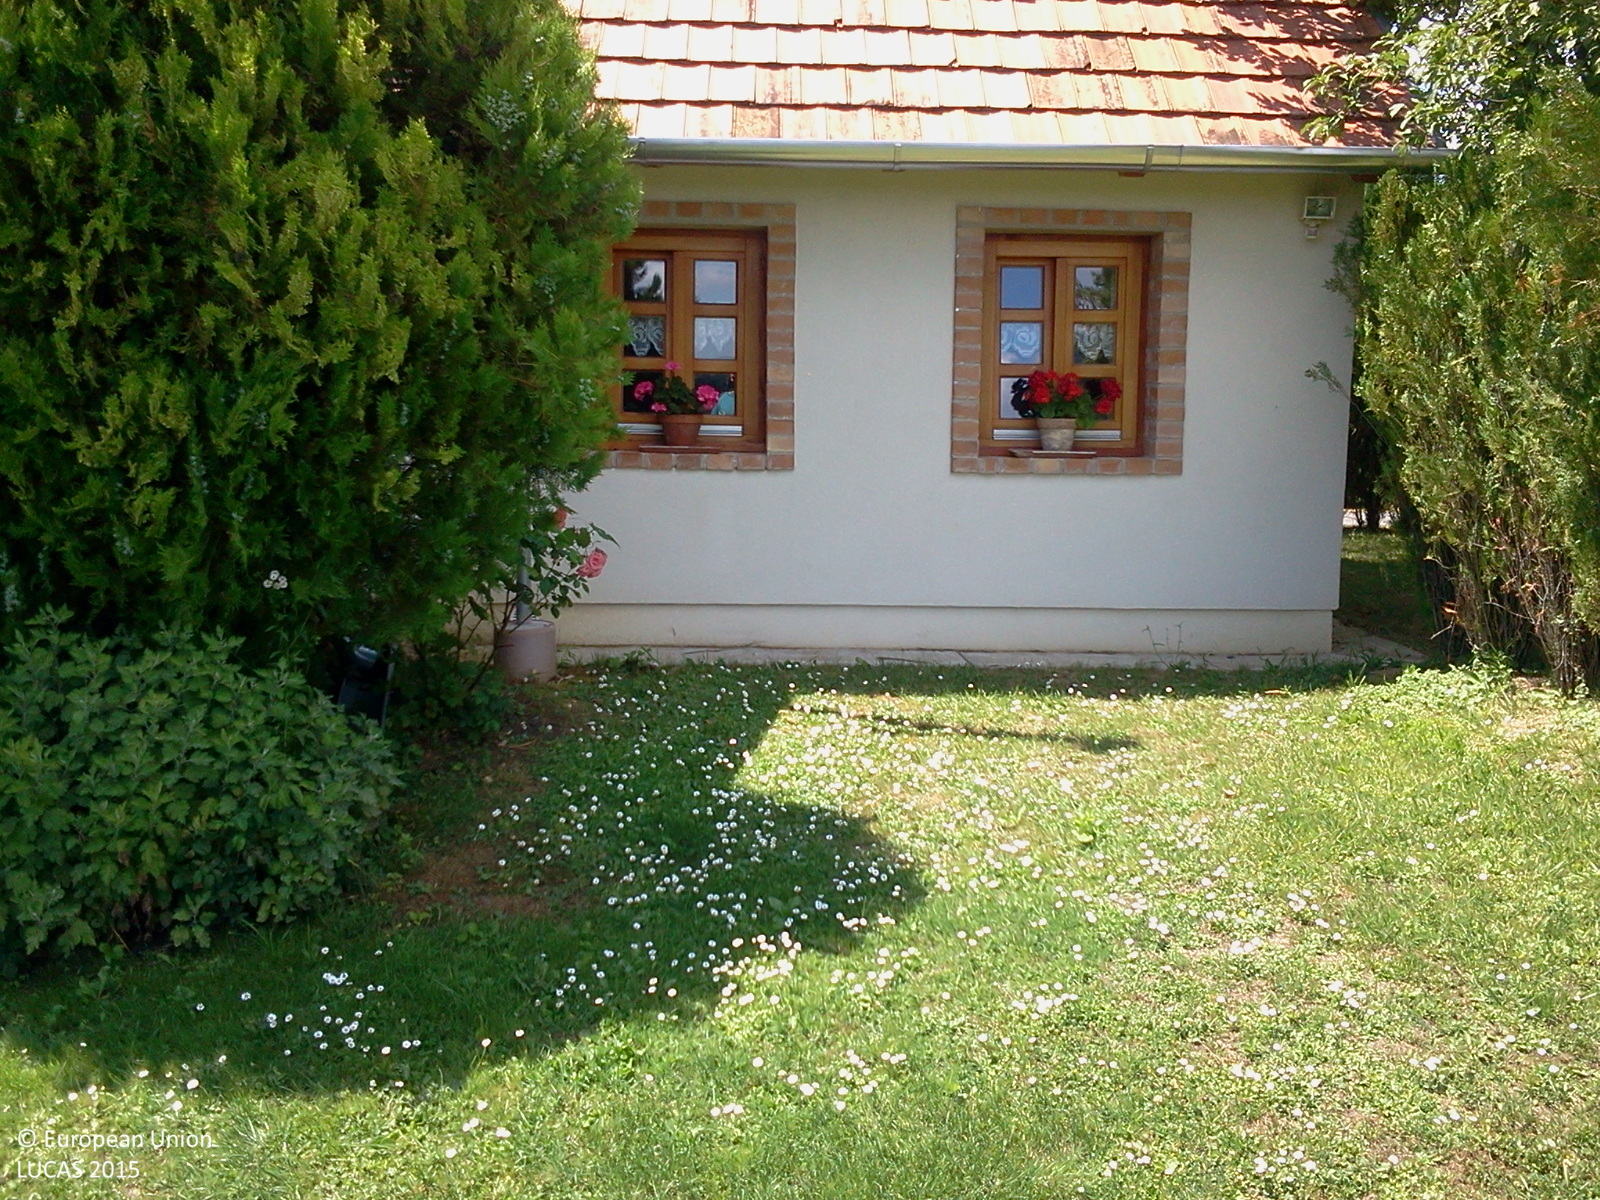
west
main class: Grassland
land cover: Grassland without tree/shrub cover
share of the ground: > 75 %
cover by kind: herbaceous plants 100 %
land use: Agriculture (excluding fallow land and kitchen gardens)
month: June
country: HU
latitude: 46.8903
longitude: 17.1311
